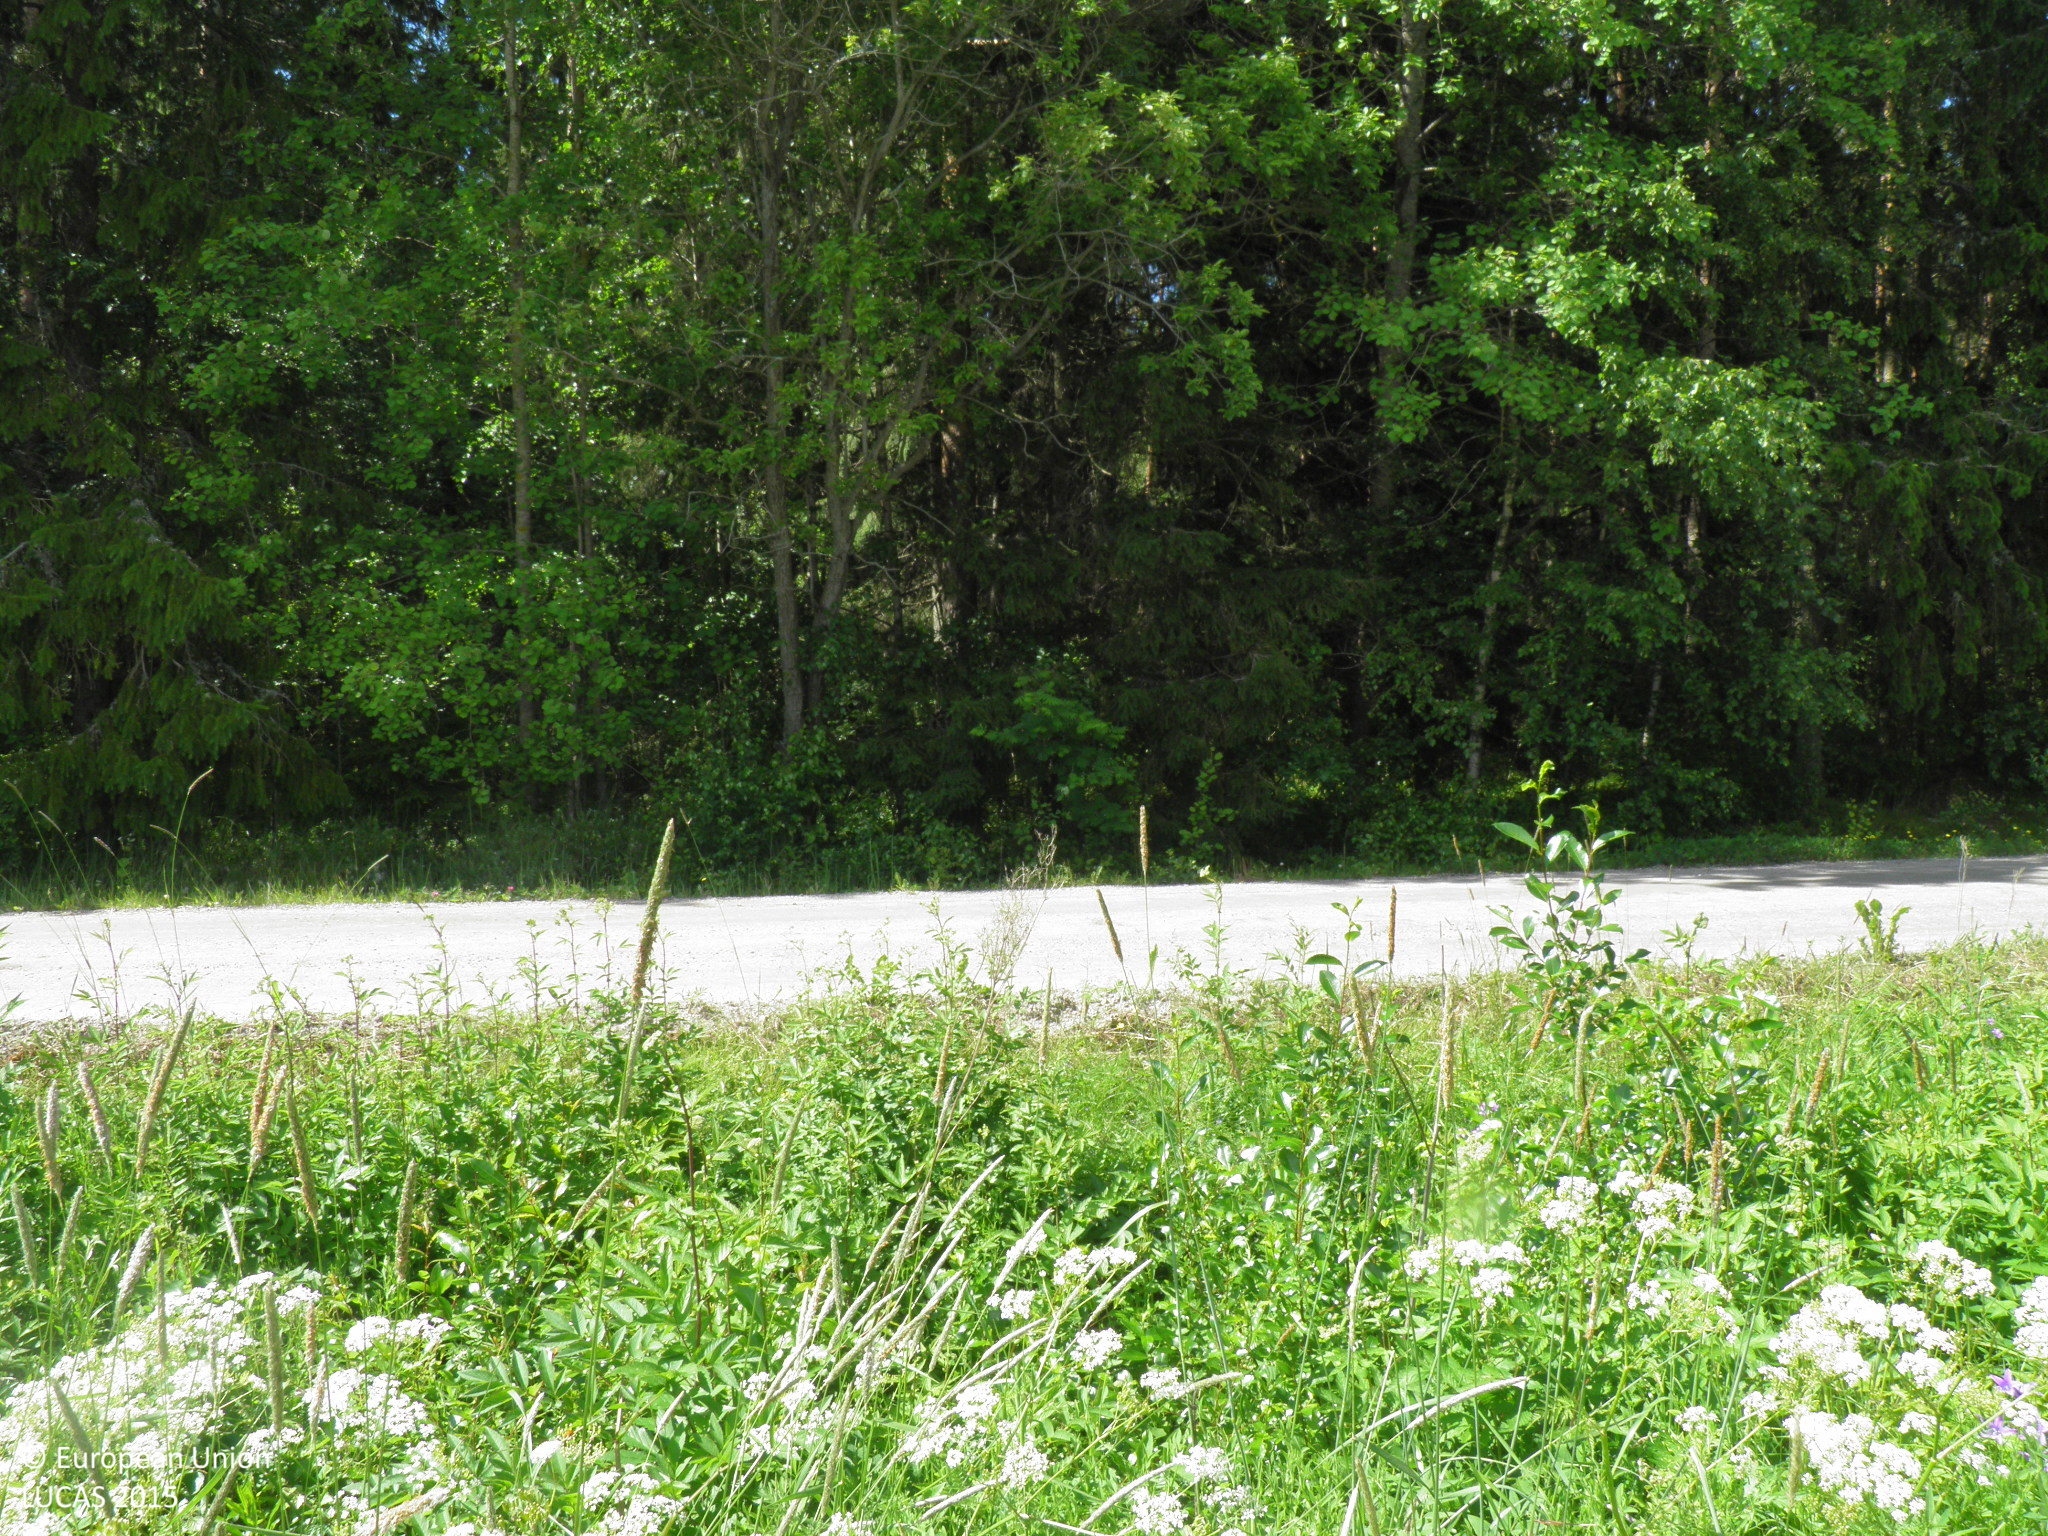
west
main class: Cropland
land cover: Barley
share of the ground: > 75 %
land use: Agriculture (excluding fallow land and kitchen gardens)
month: June
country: FI
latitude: 60.5111
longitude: 22.7679
